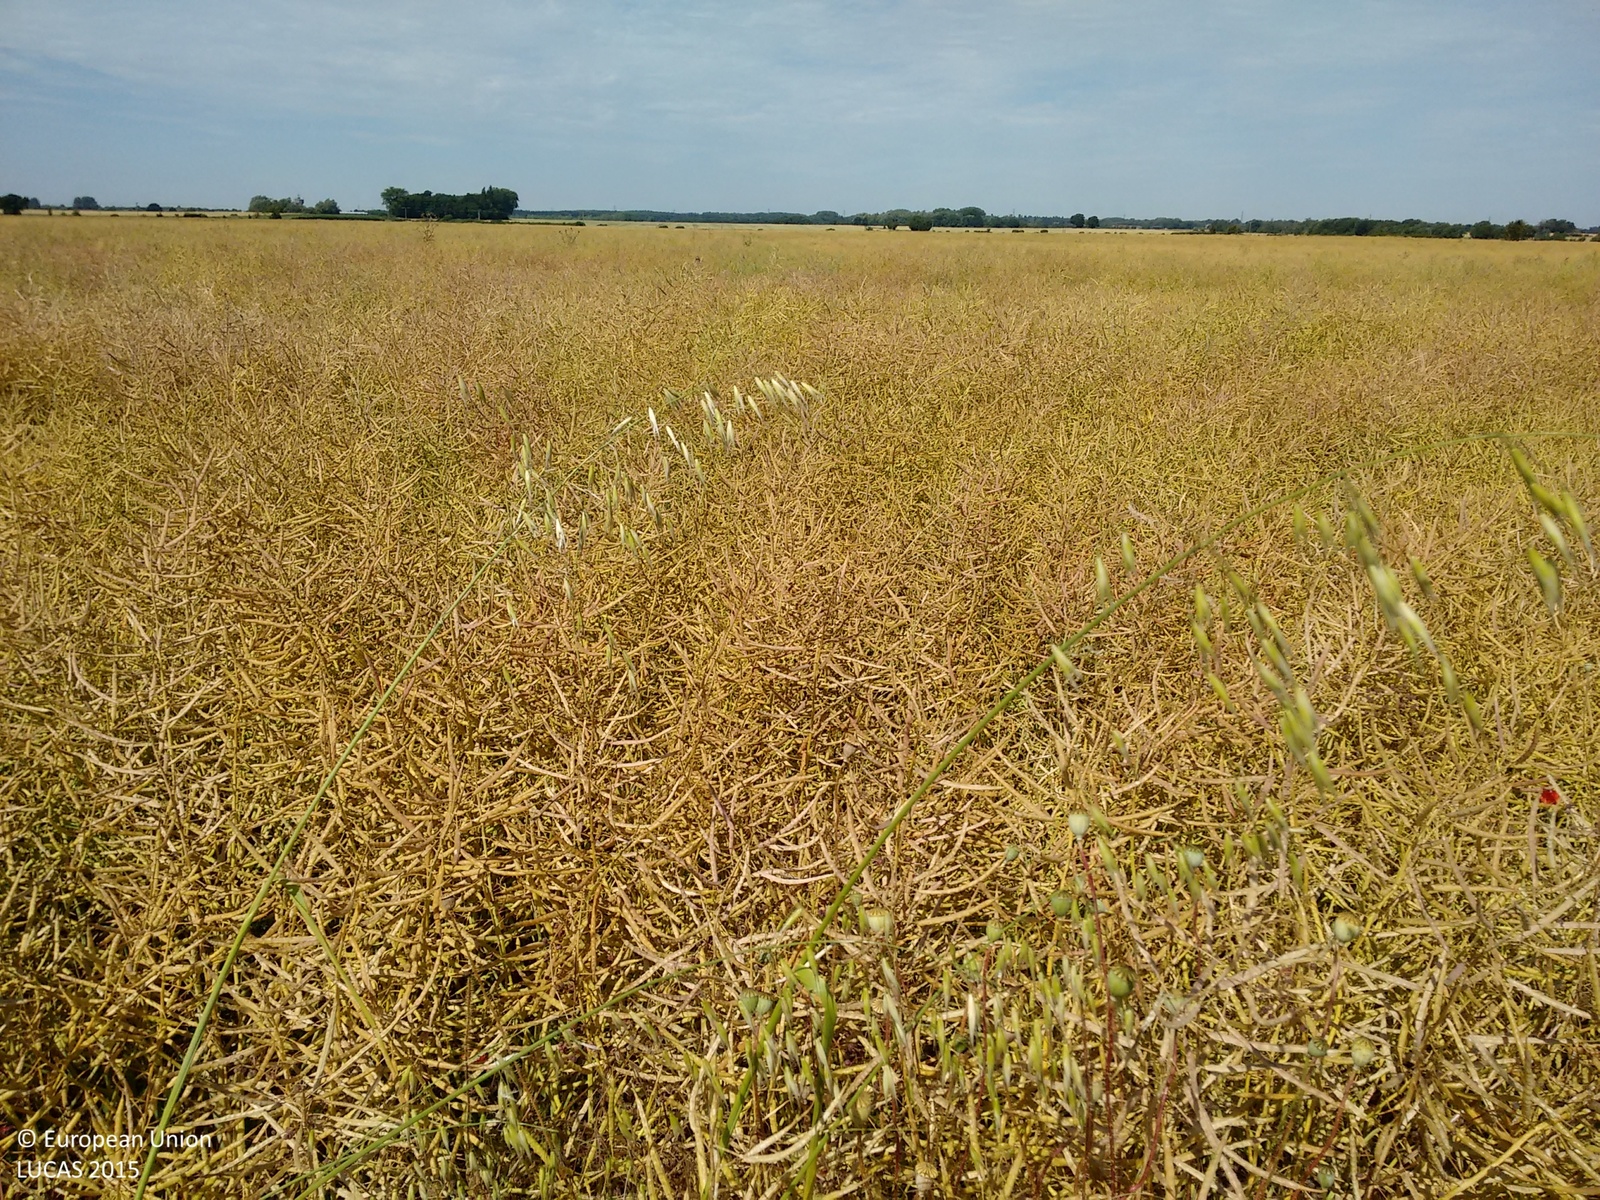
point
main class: Cropland
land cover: Rape and turnip rape
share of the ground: > 75 %
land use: Agriculture (excluding fallow land and kitchen gardens)
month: July
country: GB
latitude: 51.6701
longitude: -1.1367
